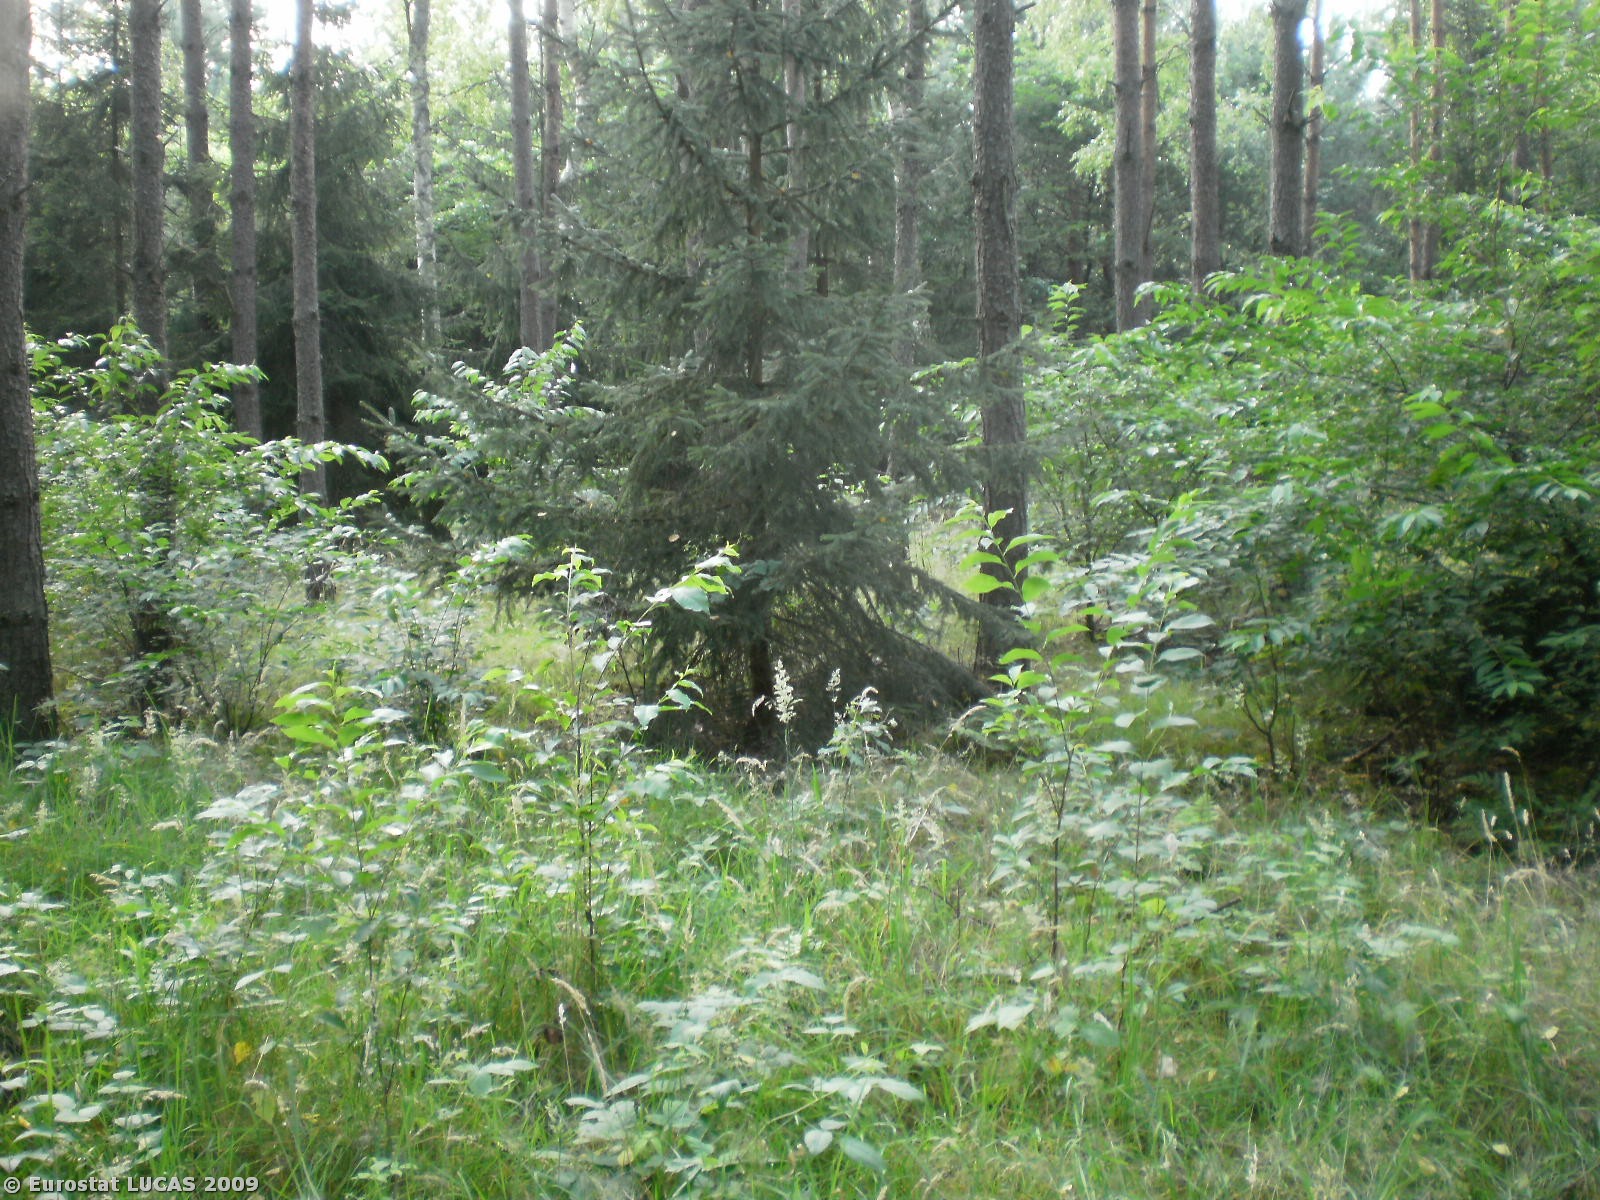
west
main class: Woodland
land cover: Mixed woodland
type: hemiboreal forest and nemoral coniferous forest and mixed broadleaved-coniferous forest
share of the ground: > 75 %
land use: Forestry
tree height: > 5 m
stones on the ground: < 10 %
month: July
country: PL
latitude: 53.3533
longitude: 20.9957
